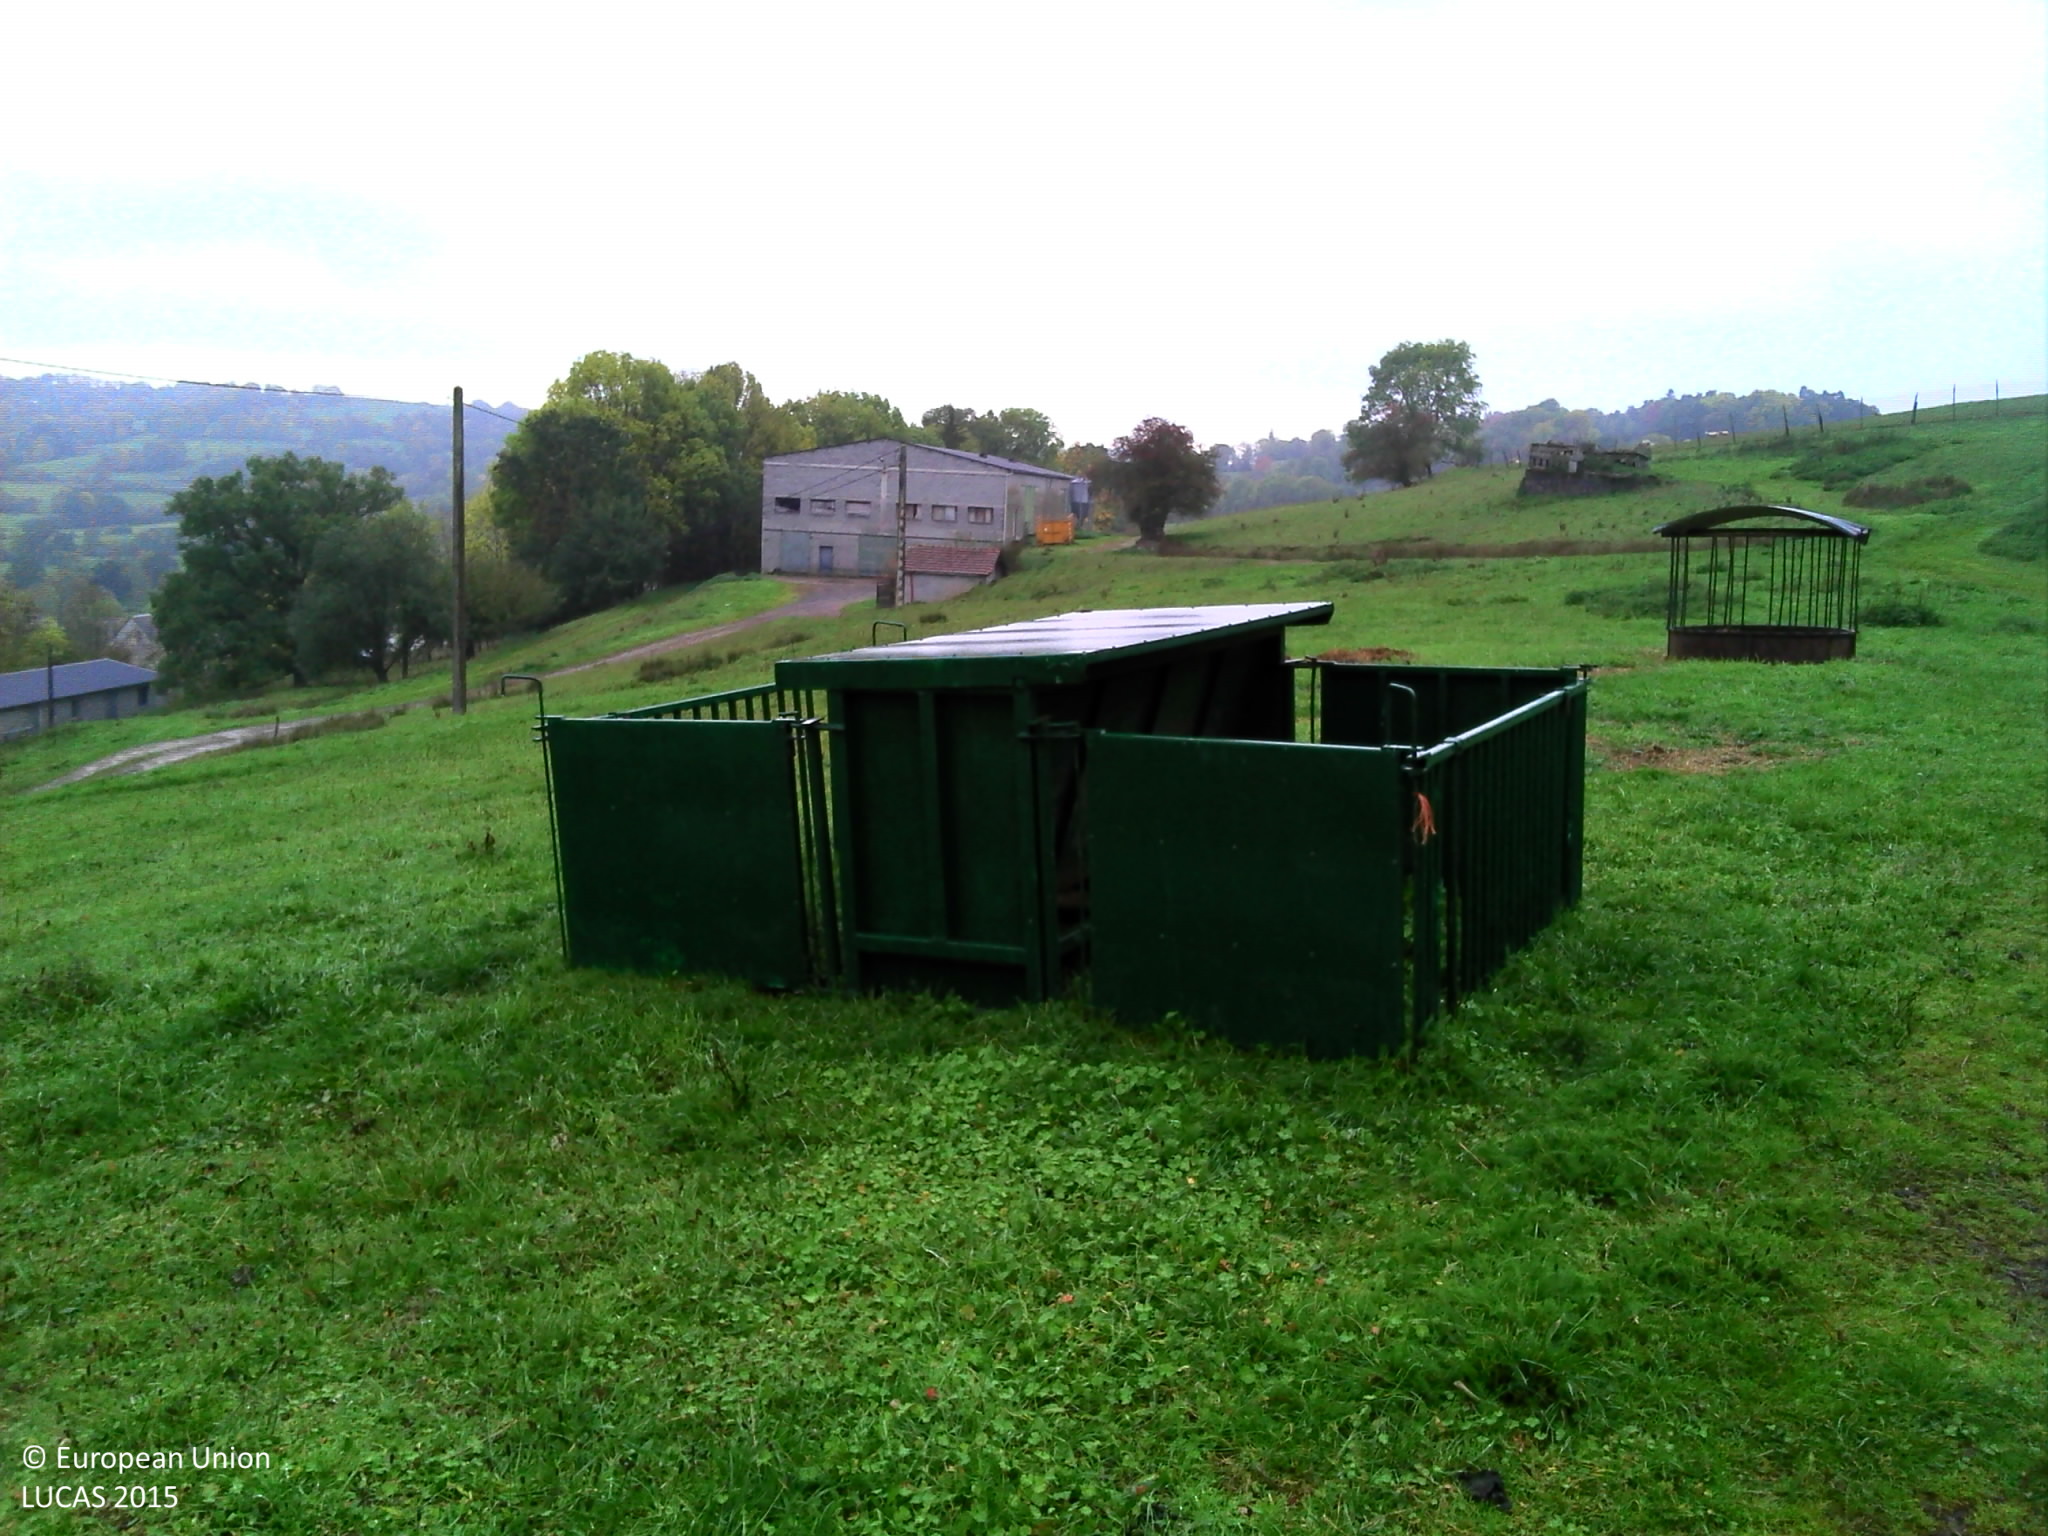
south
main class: Grassland
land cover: Grassland without tree/shrub cover
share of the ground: > 75 %
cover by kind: herbaceous plants 85 %, unconsolidated bare surface 15 %
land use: Agriculture (excluding fallow land and kitchen gardens)
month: October
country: FR
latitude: 45.7477
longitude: 2.8134
